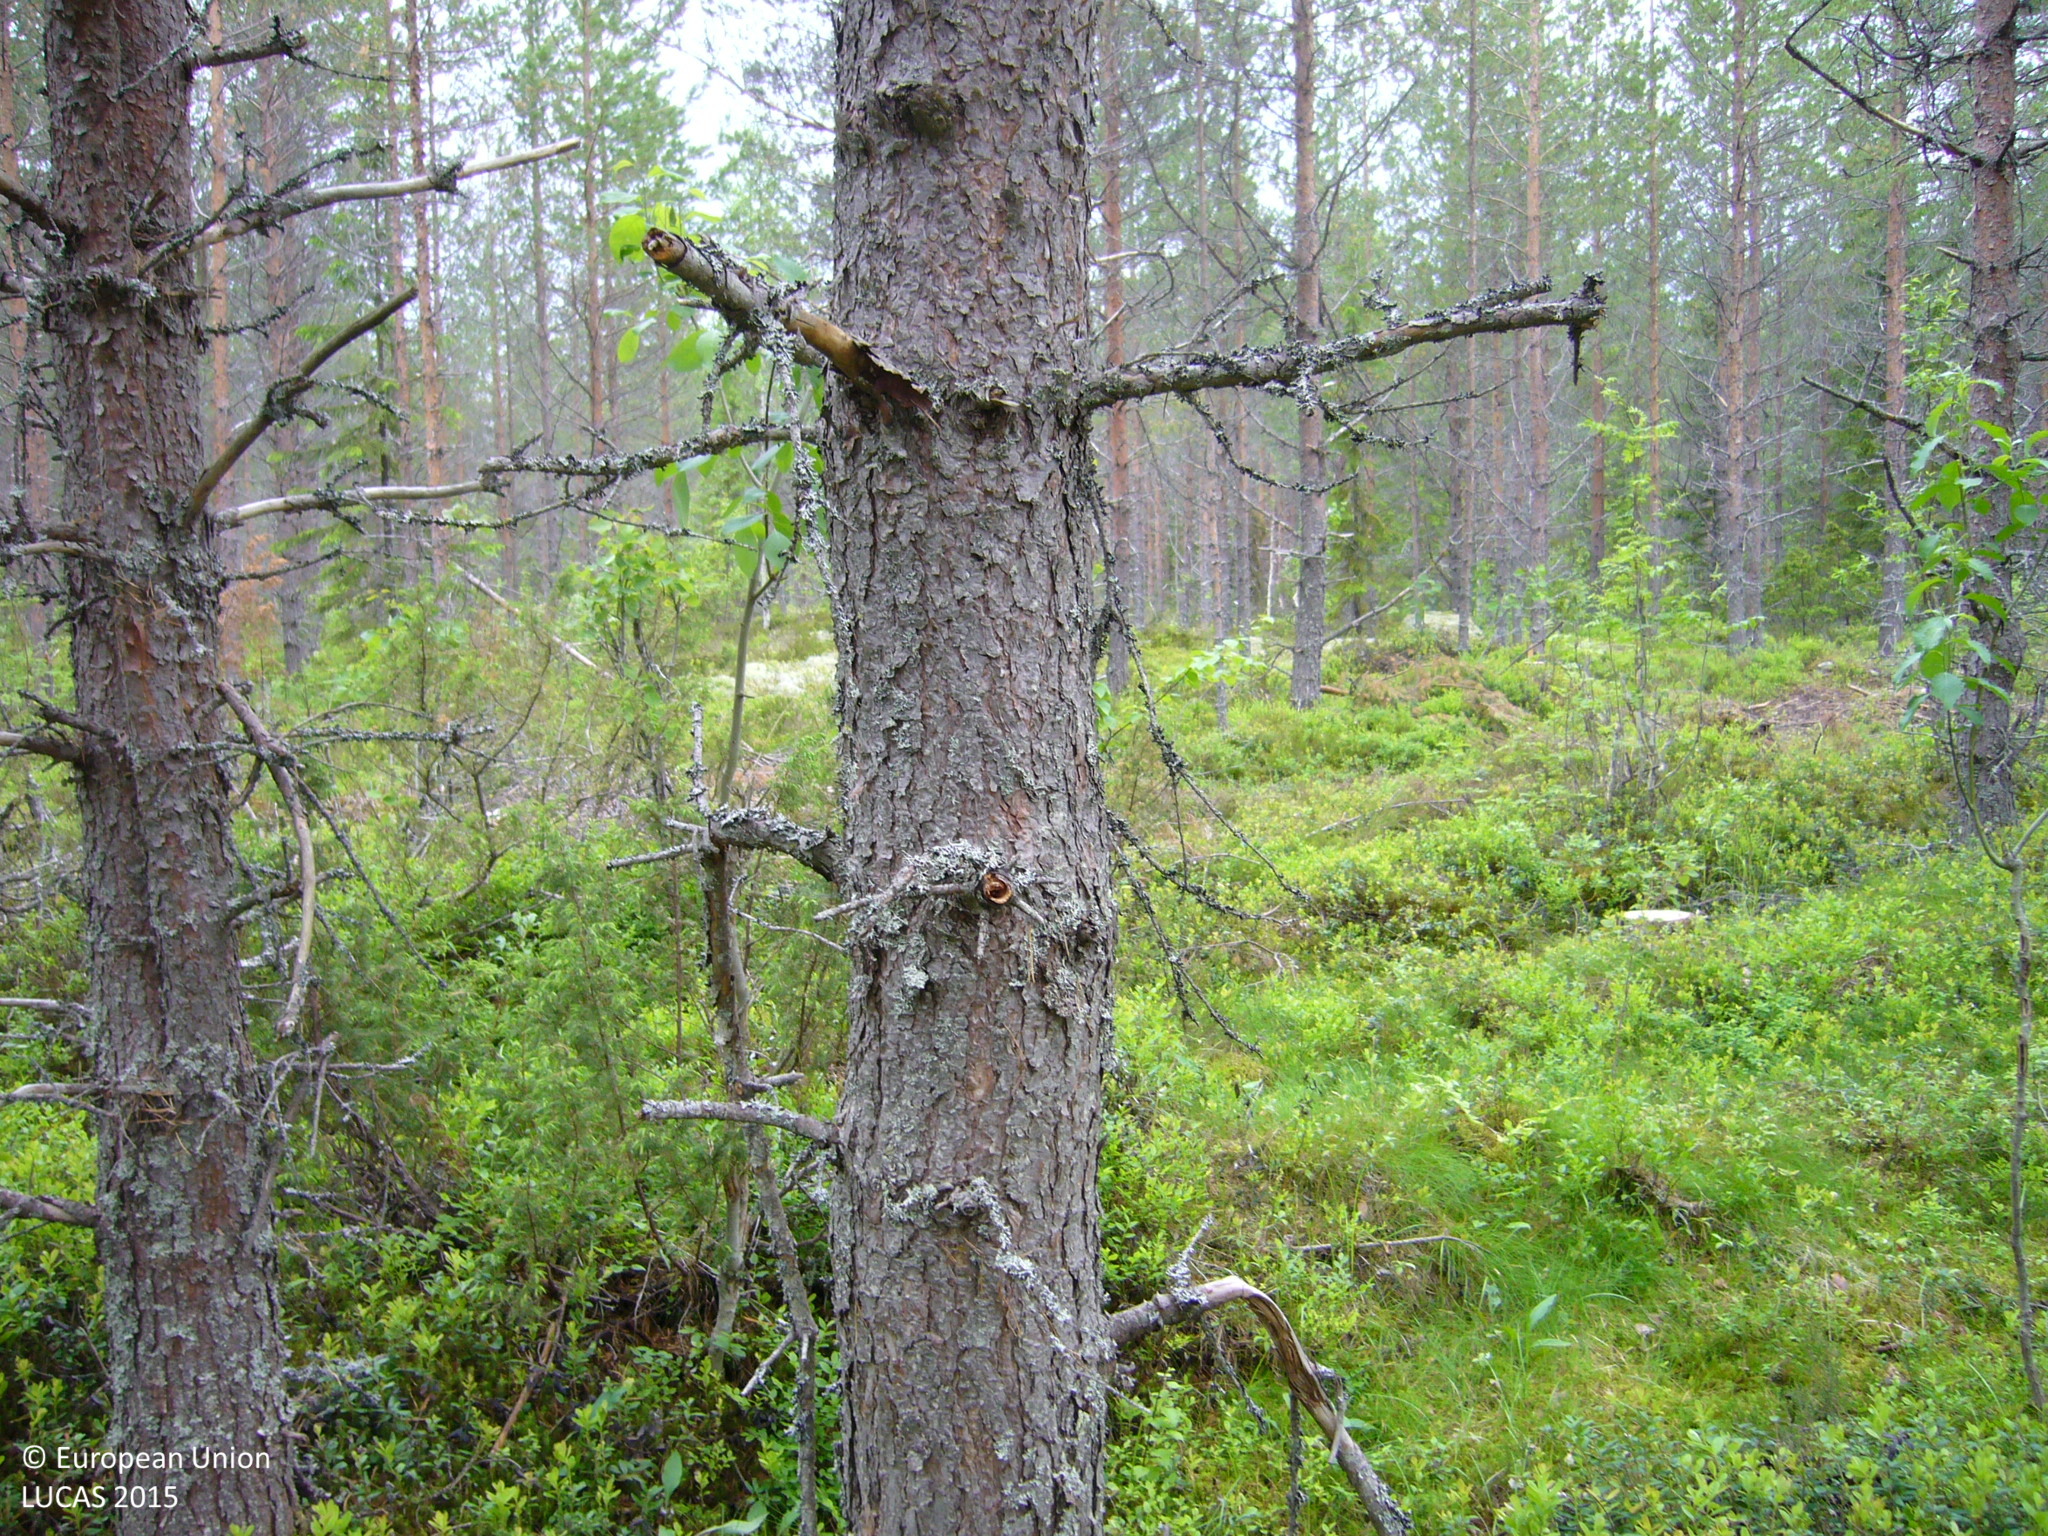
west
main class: Woodland
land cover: Pine dominated coniferous woodland
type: boreal forest
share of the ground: 50 - 75 %
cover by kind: coniferous forest trees 60 %, shrubs 35 %, broadleaved forest trees 5 %
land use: Forestry
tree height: > 5 m
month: June
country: FI
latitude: 63.7875
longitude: 26.1237
